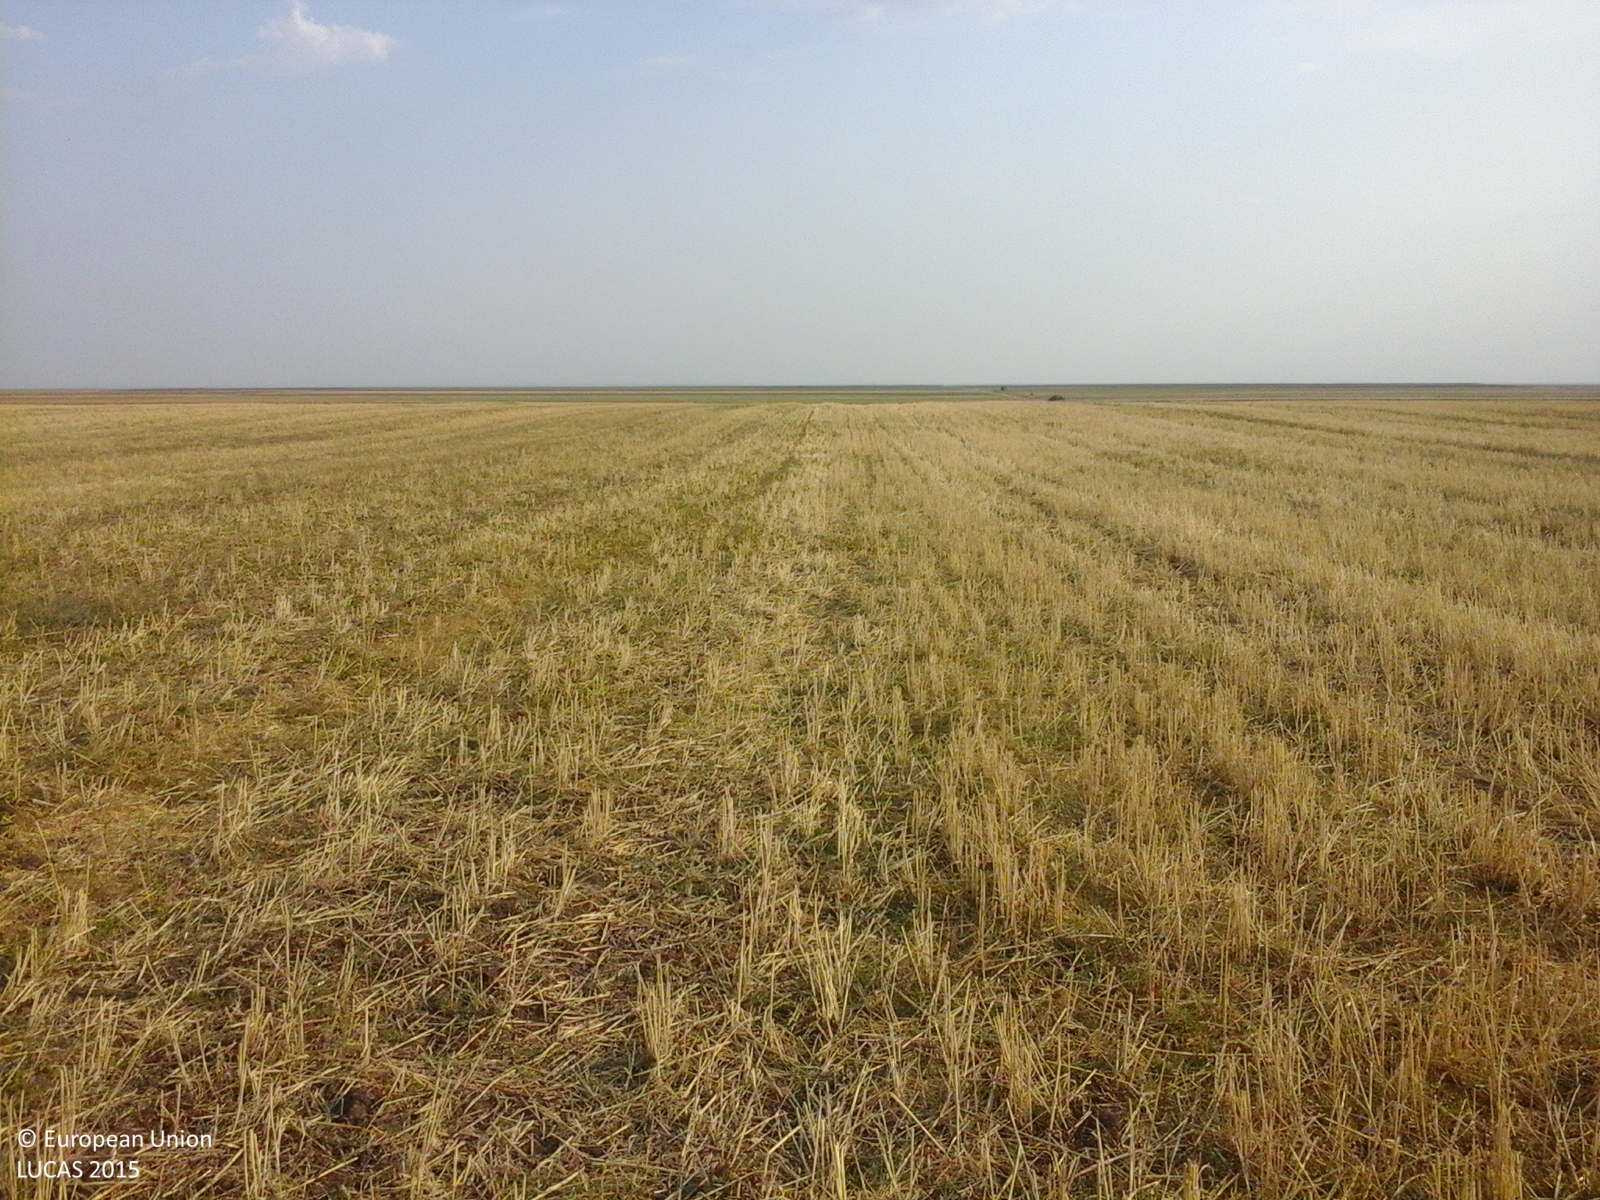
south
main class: Cropland
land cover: Common wheat
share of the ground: 25 - 50 %
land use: Agriculture (excluding fallow land and kitchen gardens)
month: August
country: RO
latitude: 44.2454
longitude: 23.1061
